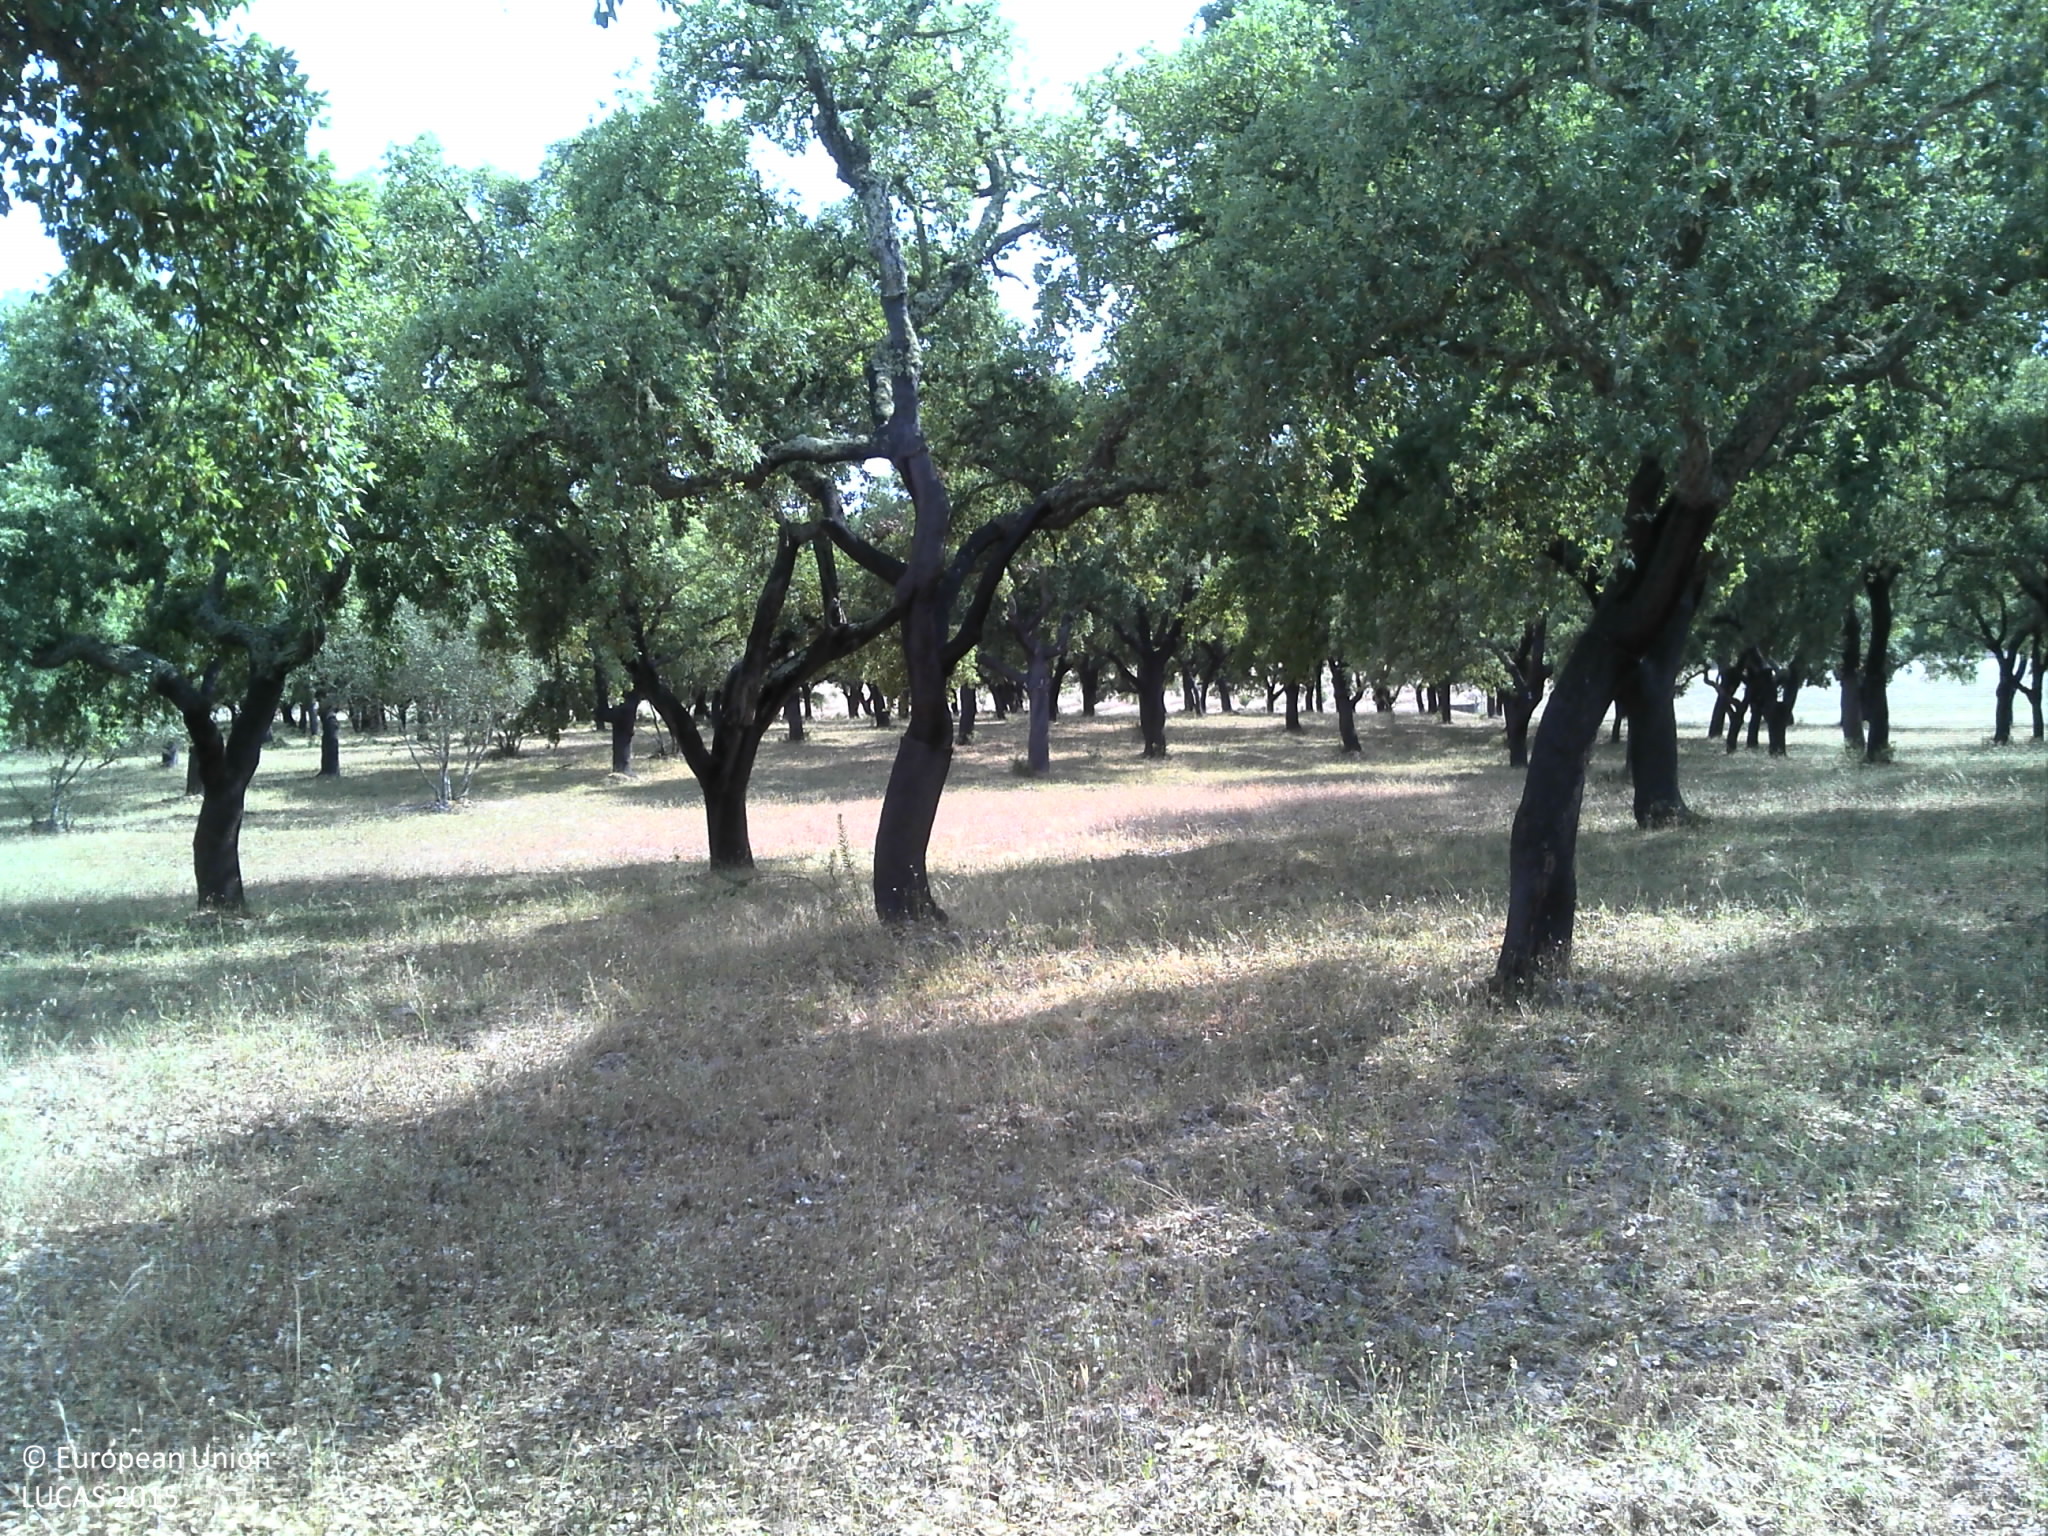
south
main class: Woodland
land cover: Broadleaved woodland
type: broadleaved evergreen forest
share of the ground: 50 - 75 %
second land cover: Grassland without tree/shrub cover
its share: 10 - 25 %
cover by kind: broadleaved forest trees 60 %, herbaceous plants 20 %, unconsolidated bare surface 20 %
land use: Forestry
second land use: Agriculture (excluding fallow land and kitchen gardens)
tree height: > 5 m
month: May
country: PT
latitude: 38.0694
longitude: -8.3819
